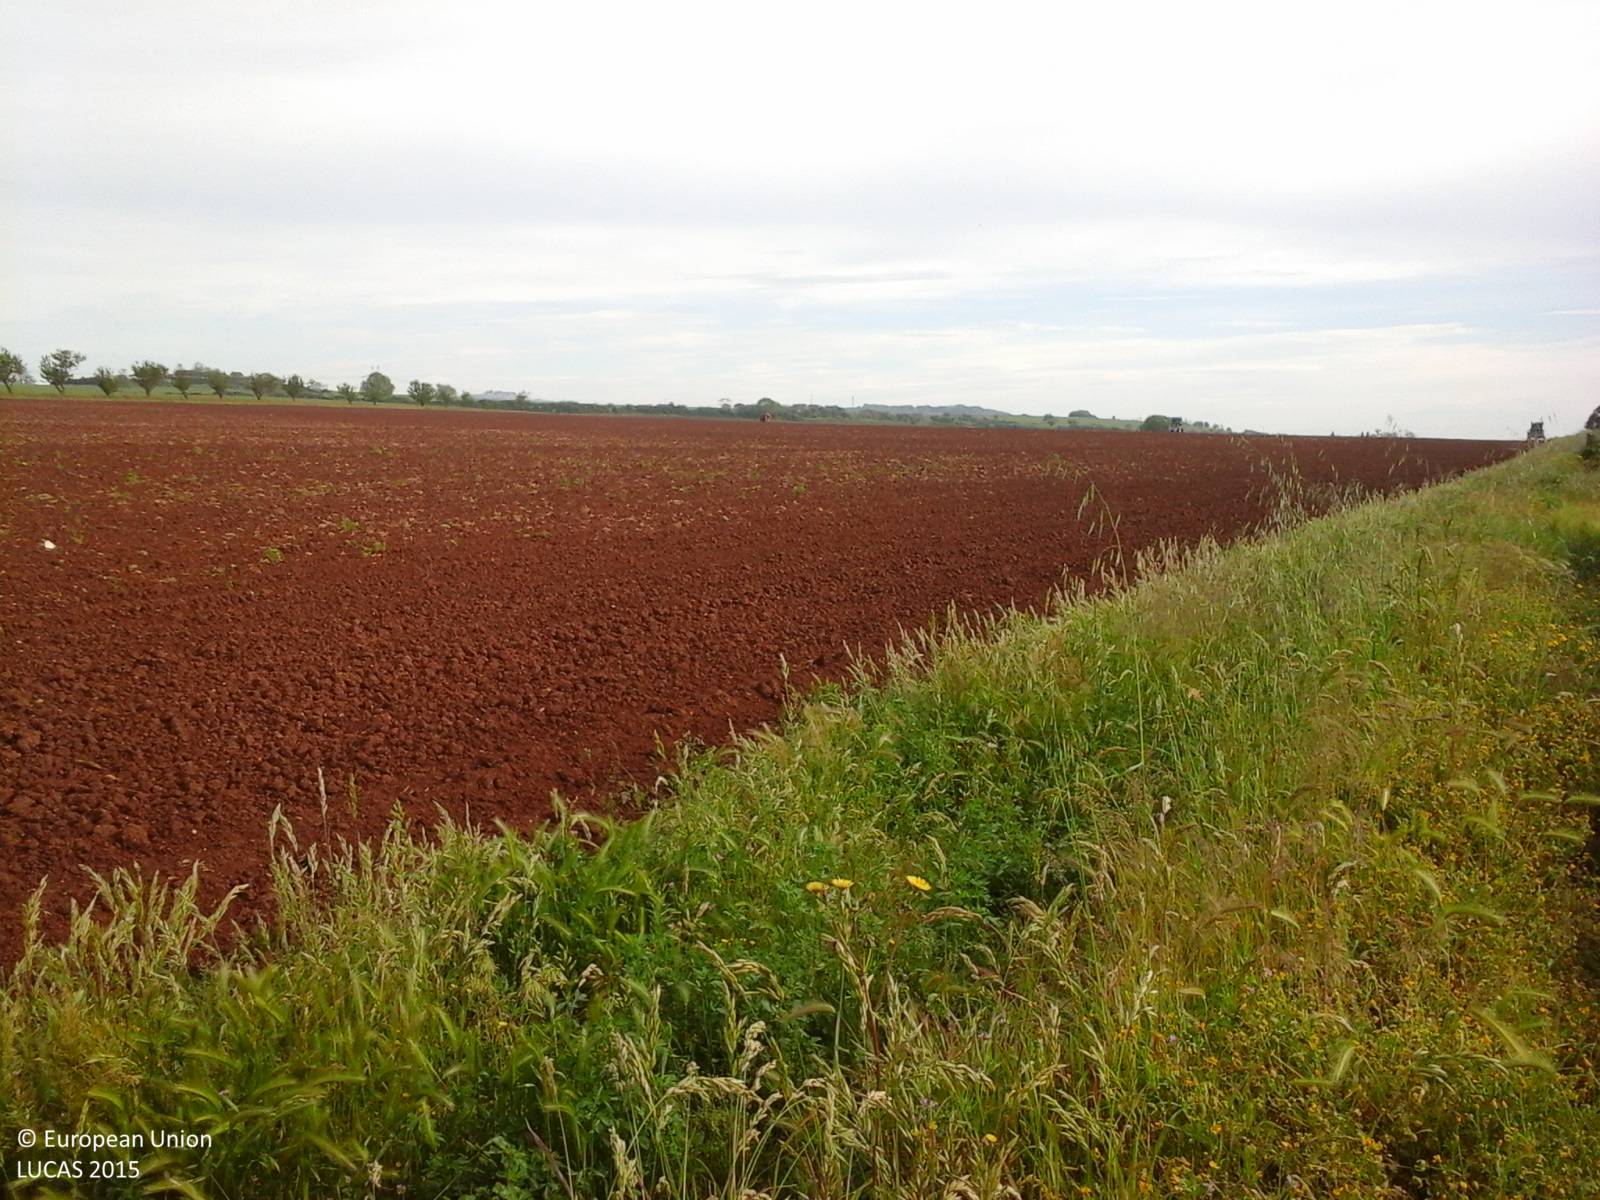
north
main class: Cropland
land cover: Durum wheat
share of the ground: > 75 %
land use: Agriculture (excluding fallow land and kitchen gardens)
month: May
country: IT
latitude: 42.4526
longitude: 12.0480
